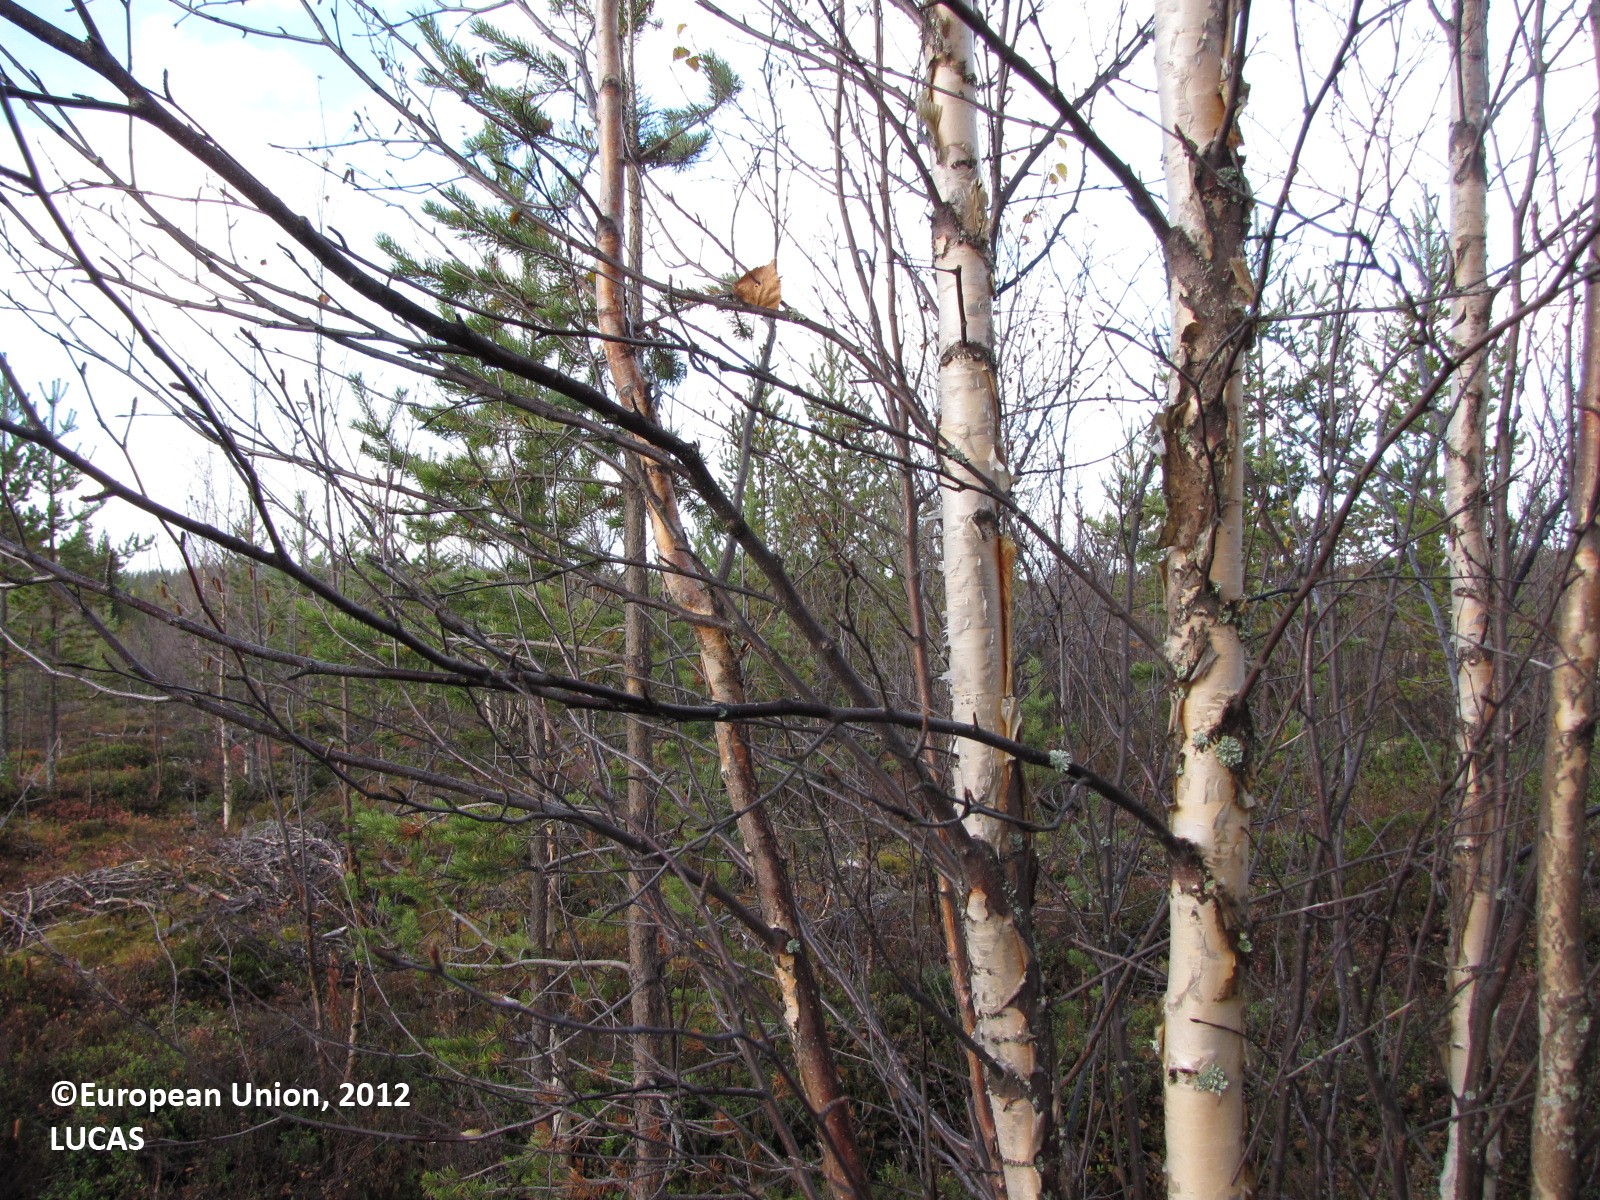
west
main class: Woodland
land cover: Pine dominated mixed woodland
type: boreal forest
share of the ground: 25 - 50 %
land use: Forestry
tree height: > 5 m
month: September
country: FI
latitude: 67.8032
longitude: 23.6525
